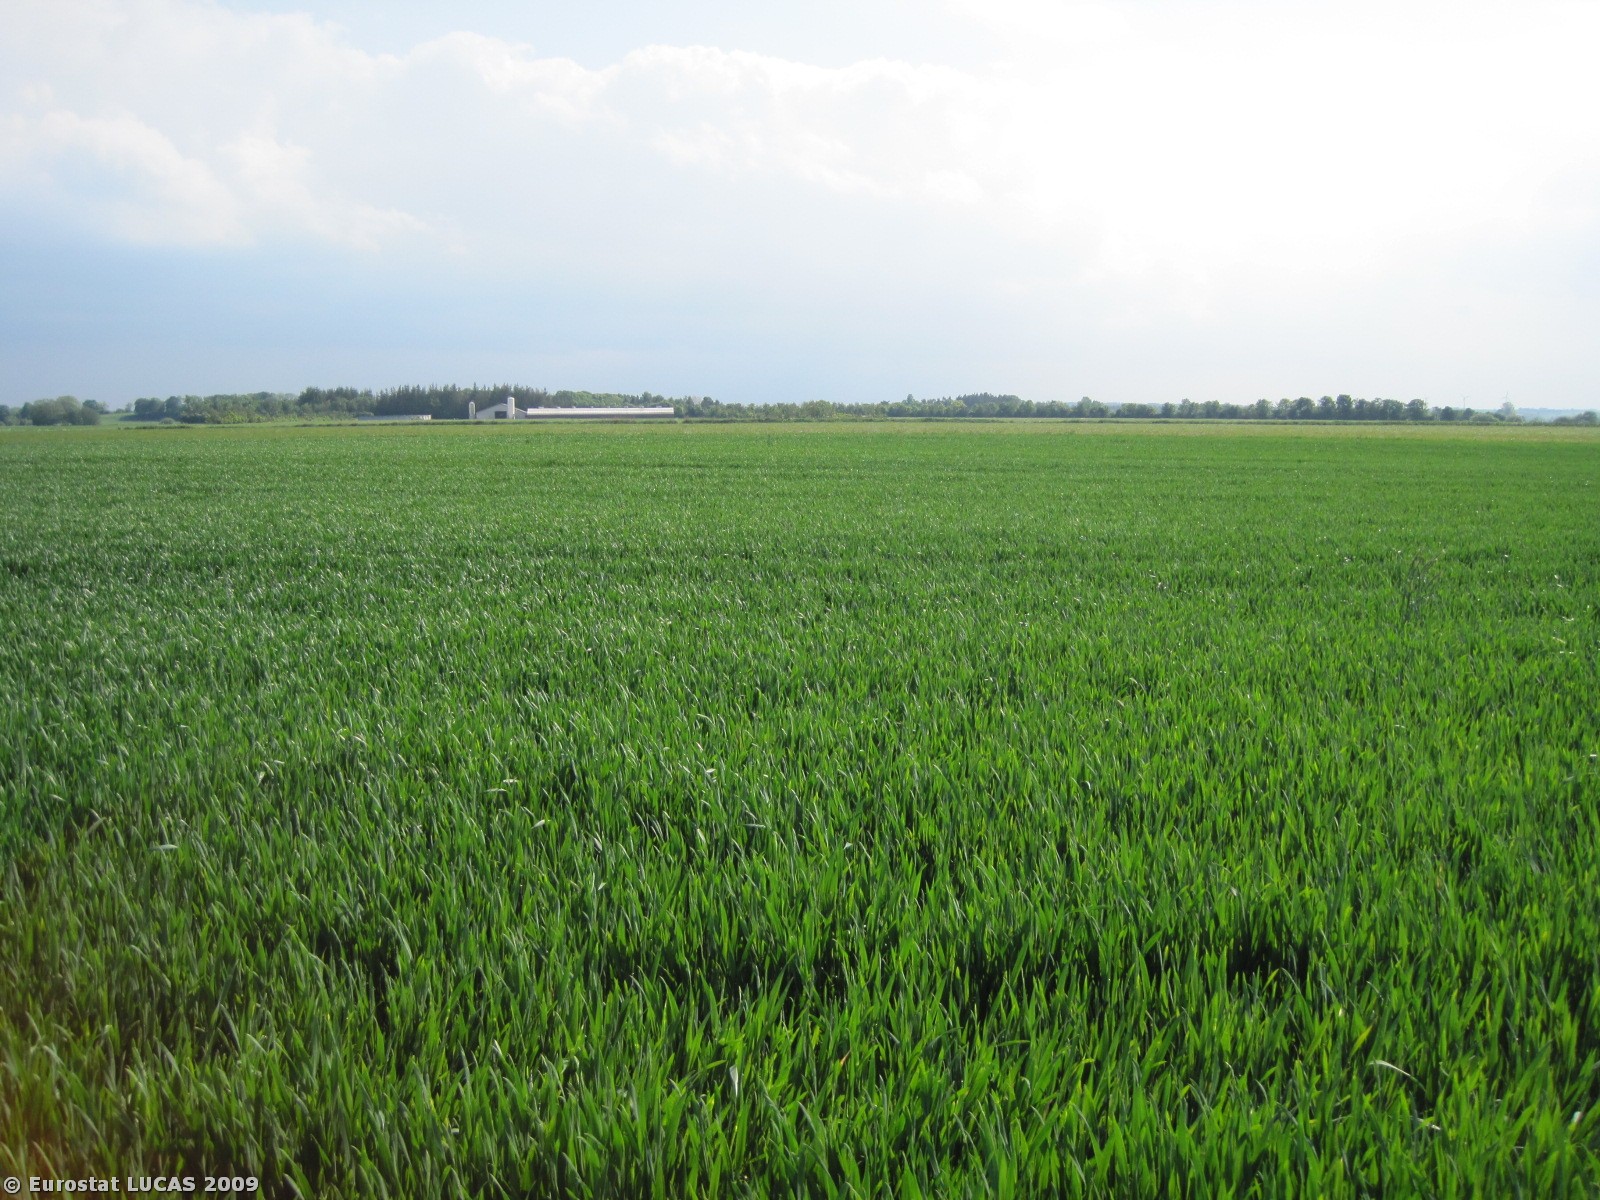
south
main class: Cropland
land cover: Common wheat
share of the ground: > 75 %
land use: Agriculture (excluding fallow land and kitchen gardens)
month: May
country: DK
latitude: 56.6728
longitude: 10.2770
